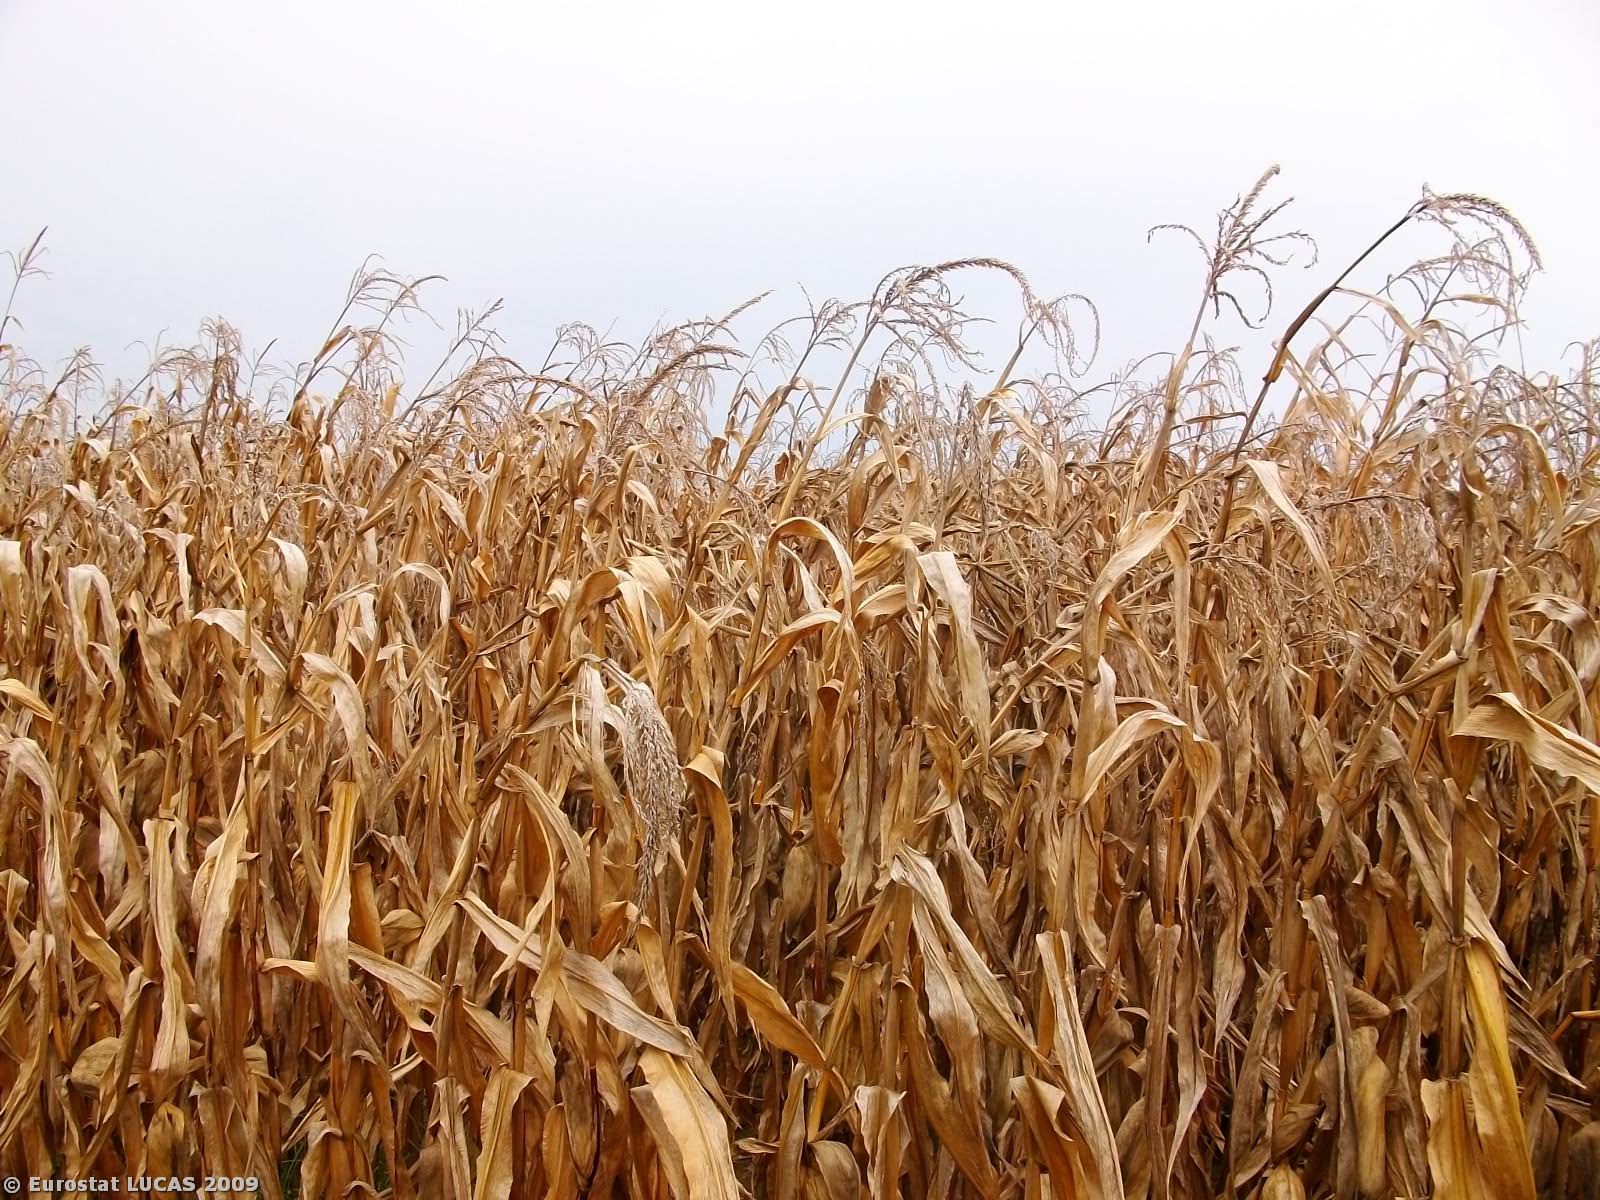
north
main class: Cropland
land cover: Maize
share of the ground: > 75 %
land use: Agriculture (excluding fallow land and kitchen gardens)
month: September
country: GR
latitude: 40.9280
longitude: 23.5925
